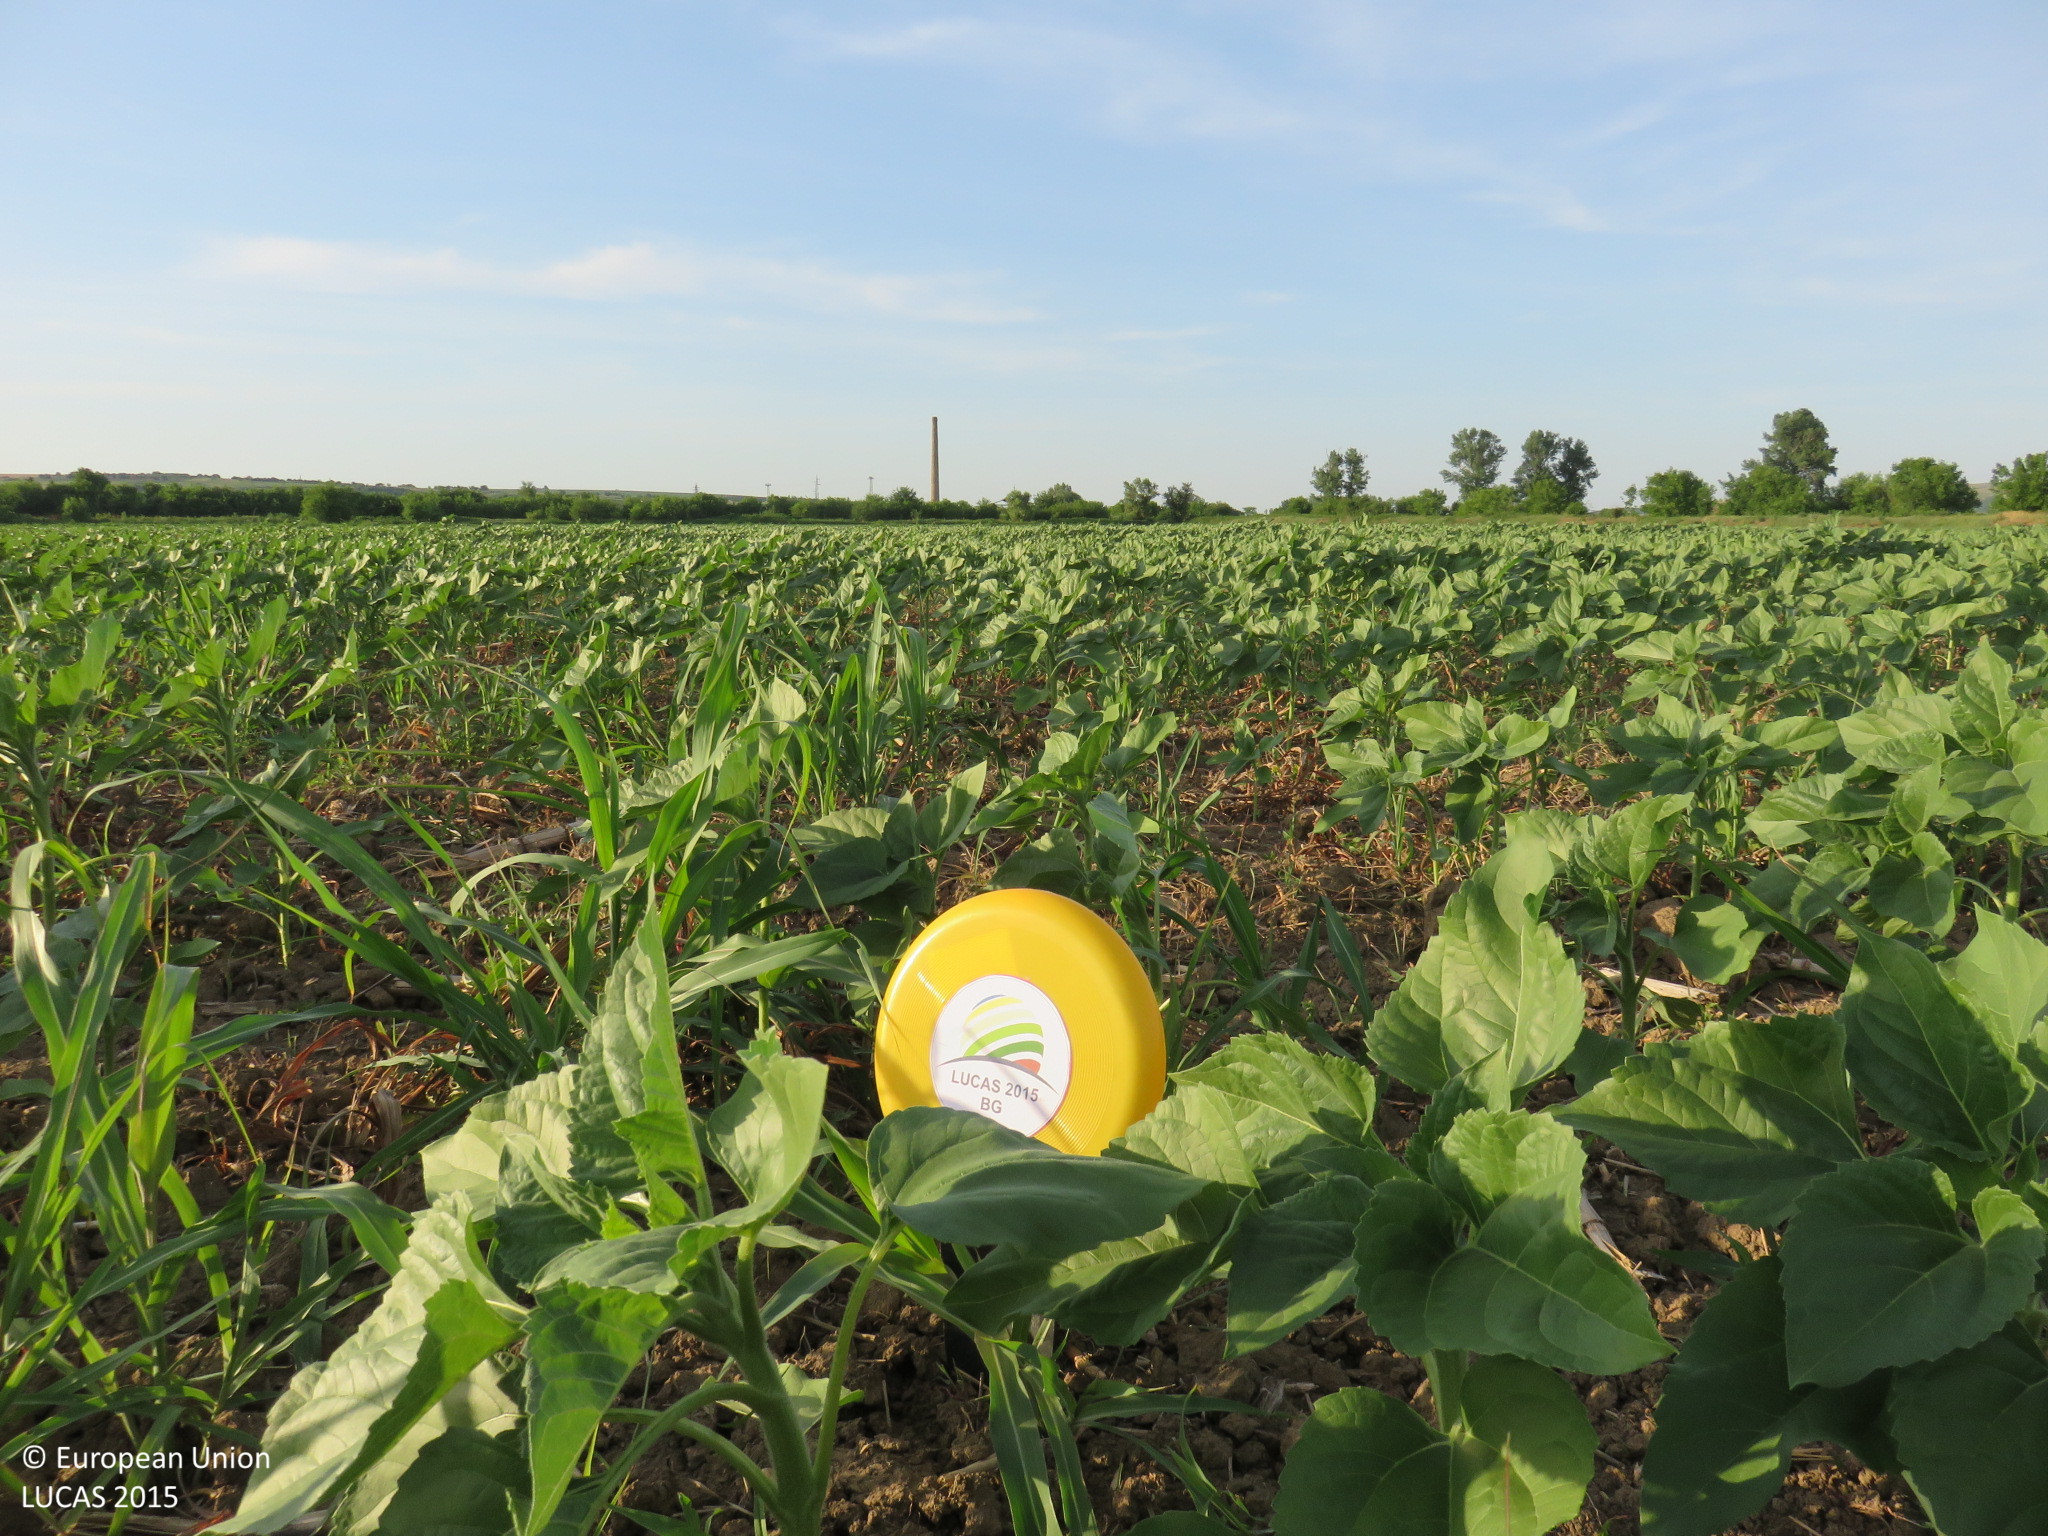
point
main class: Cropland
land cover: Sunflower
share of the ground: > 75 %
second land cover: Spontaneously vegetated surfaces
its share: 10 - 25 %
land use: Agriculture (excluding fallow land and kitchen gardens)
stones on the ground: < 10 %
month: June
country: BG
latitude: 43.6326
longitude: 24.4017
